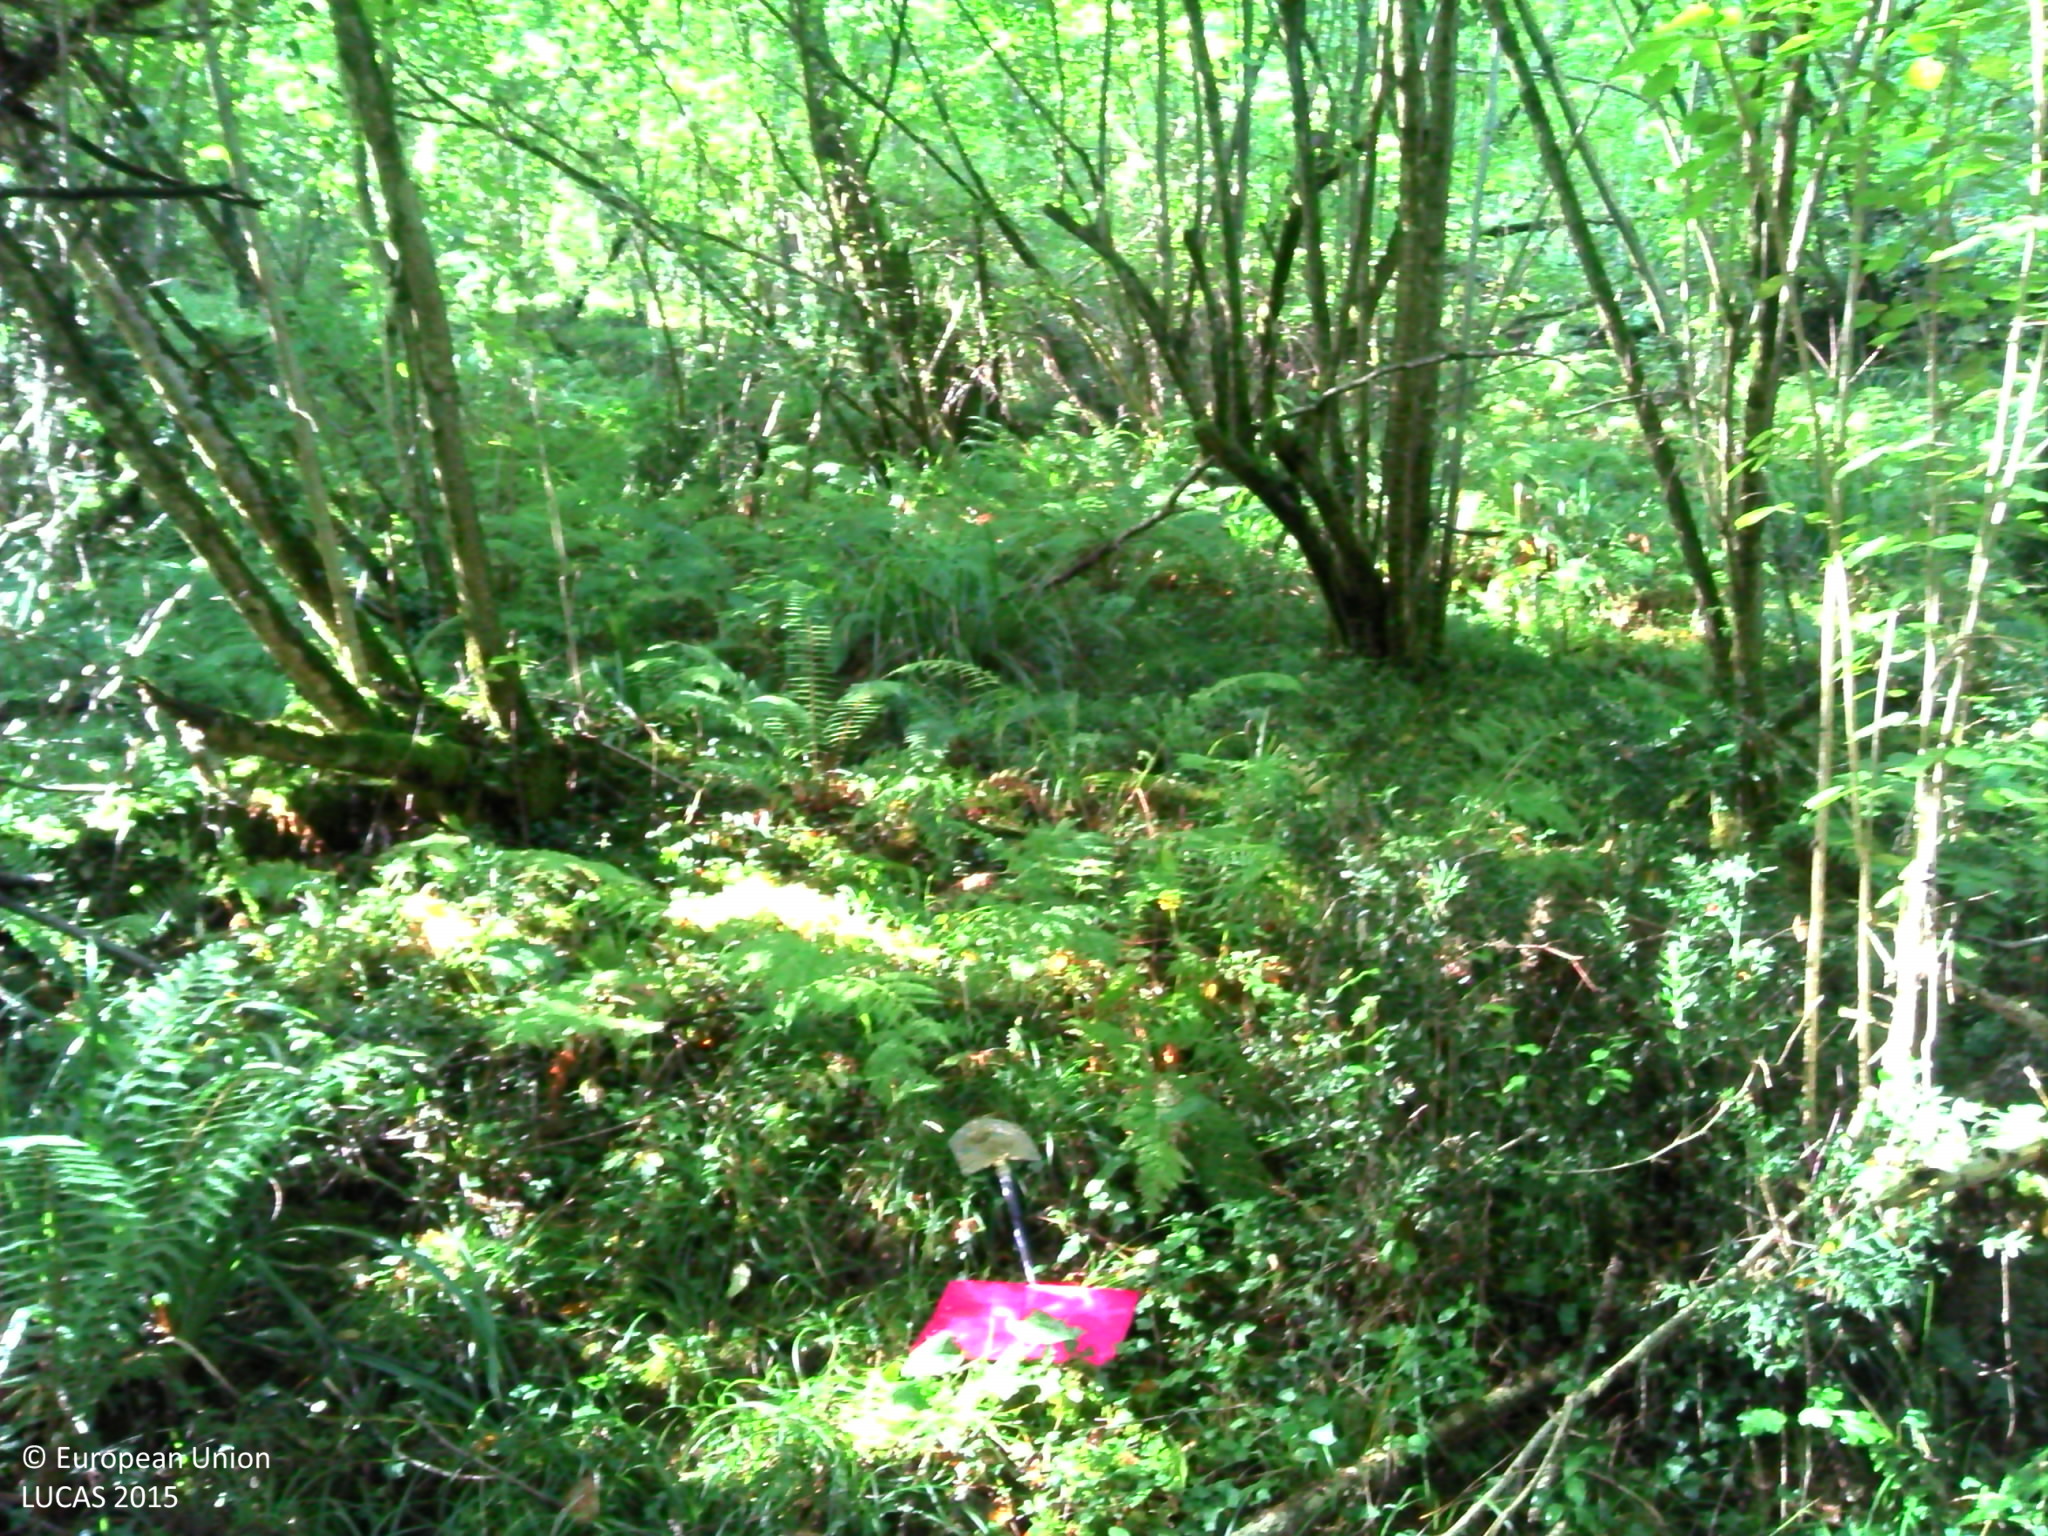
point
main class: Woodland
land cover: Broadleaved woodland
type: mesophytic deciduous forest
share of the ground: > 75 %
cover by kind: broadleaved forest trees 80 %, lichens and mosses 10 %, shrubs 5 %, herbaceous plants 5 %
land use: Forestry
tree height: > 5 m
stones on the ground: < 10 %
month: September
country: FR
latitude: 43.4629
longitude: -0.7519
